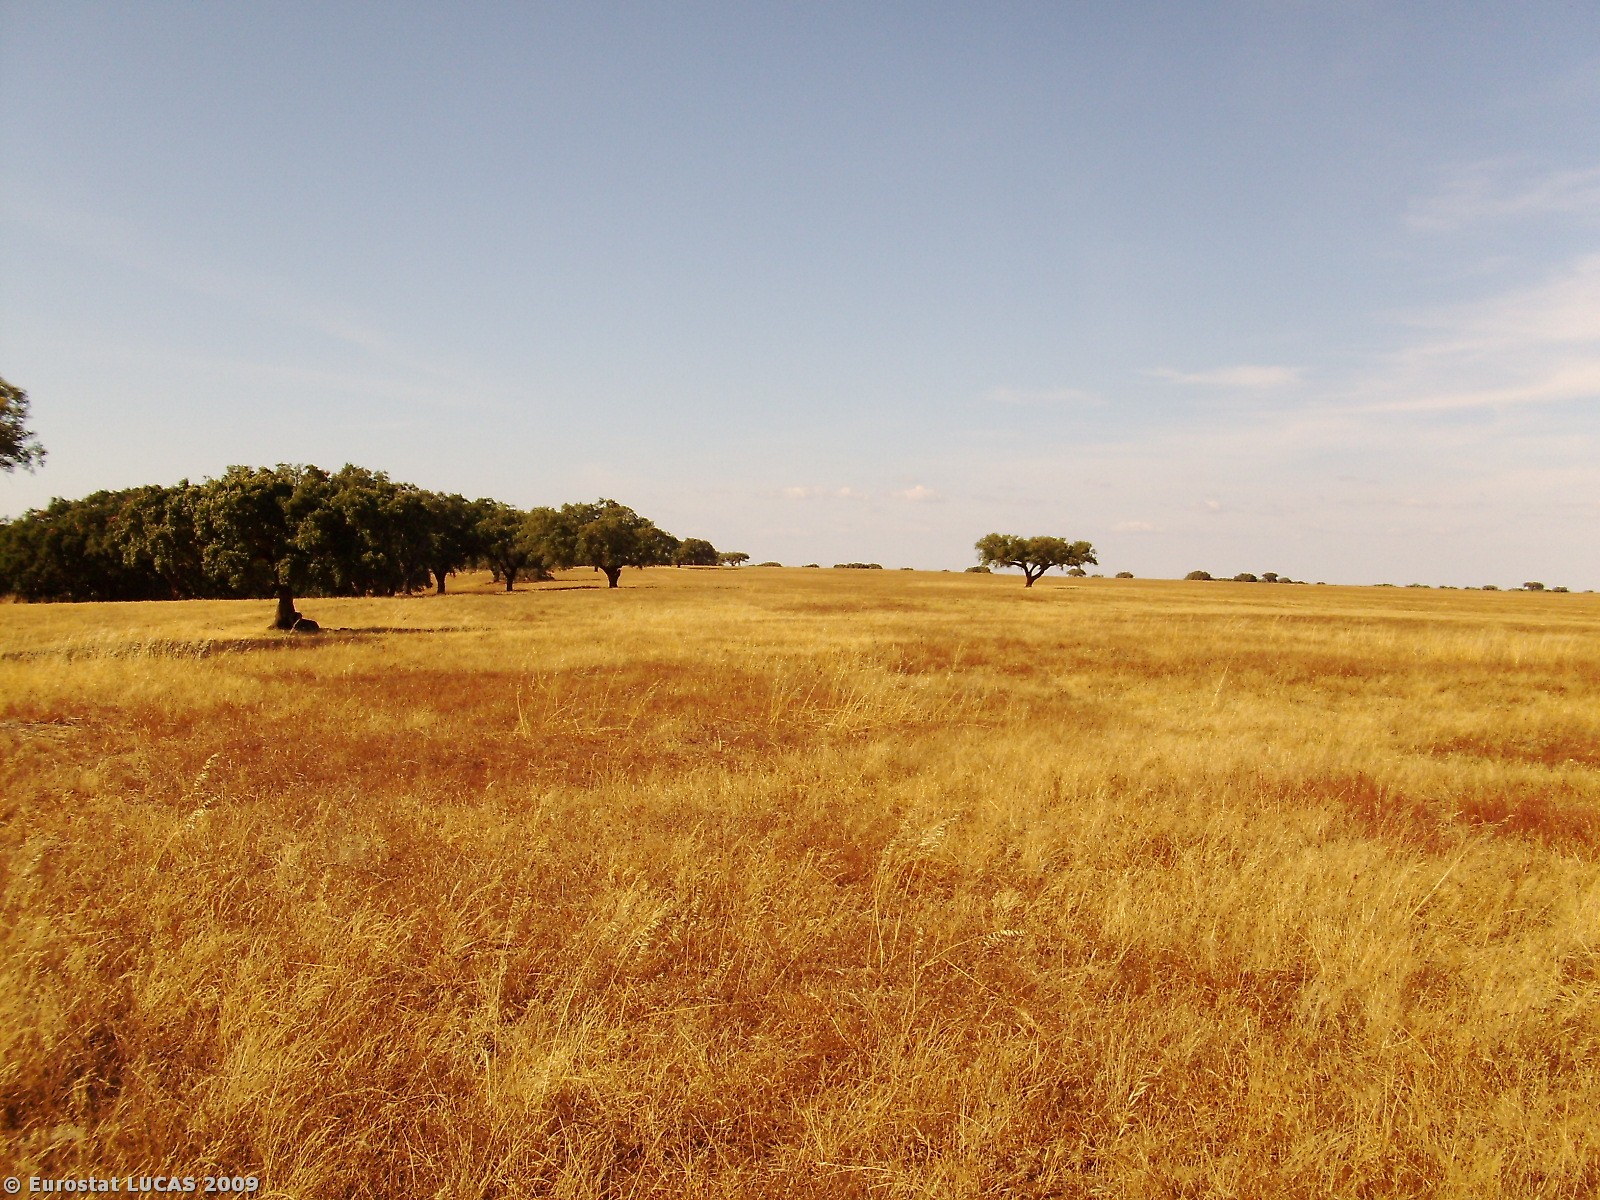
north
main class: Grassland
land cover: Grassland without tree/shrub cover
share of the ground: > 75 %
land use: Agriculture (excluding fallow land and kitchen gardens)
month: June
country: PT
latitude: 37.9991
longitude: -8.3625
